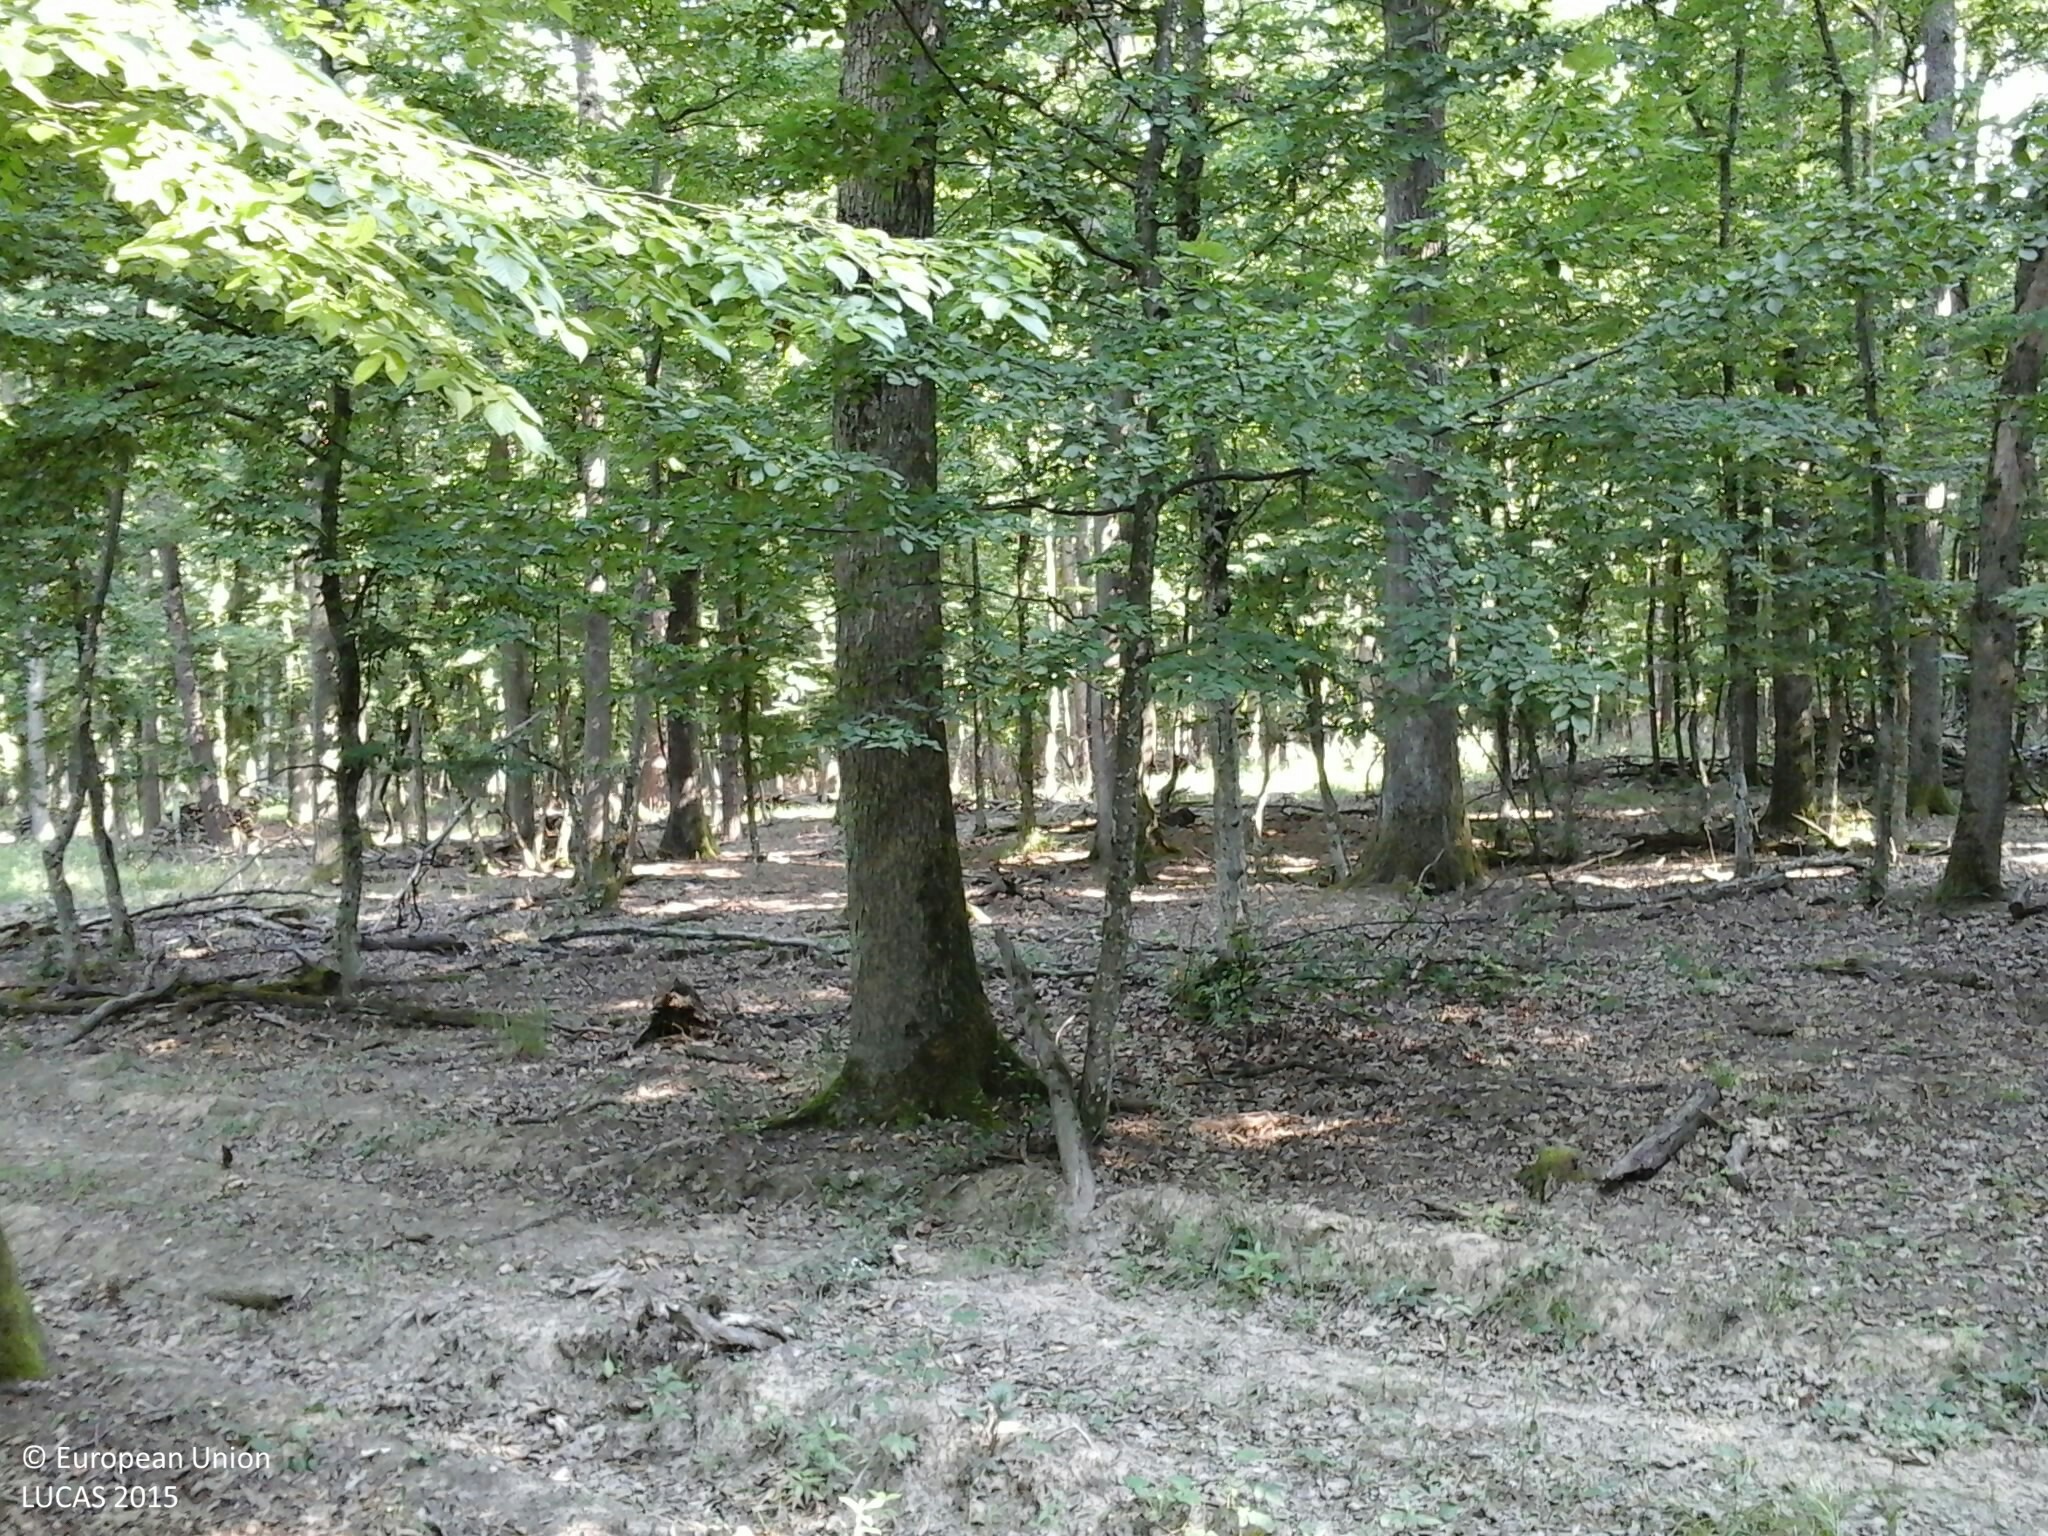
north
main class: Woodland
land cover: Broadleaved woodland
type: beech forest
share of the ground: > 75 %
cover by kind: broadleaved forest trees 95 %, shrubs 5 %
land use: Forestry
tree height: > 5 m
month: July
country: HU
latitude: 46.7249
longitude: 16.6097
